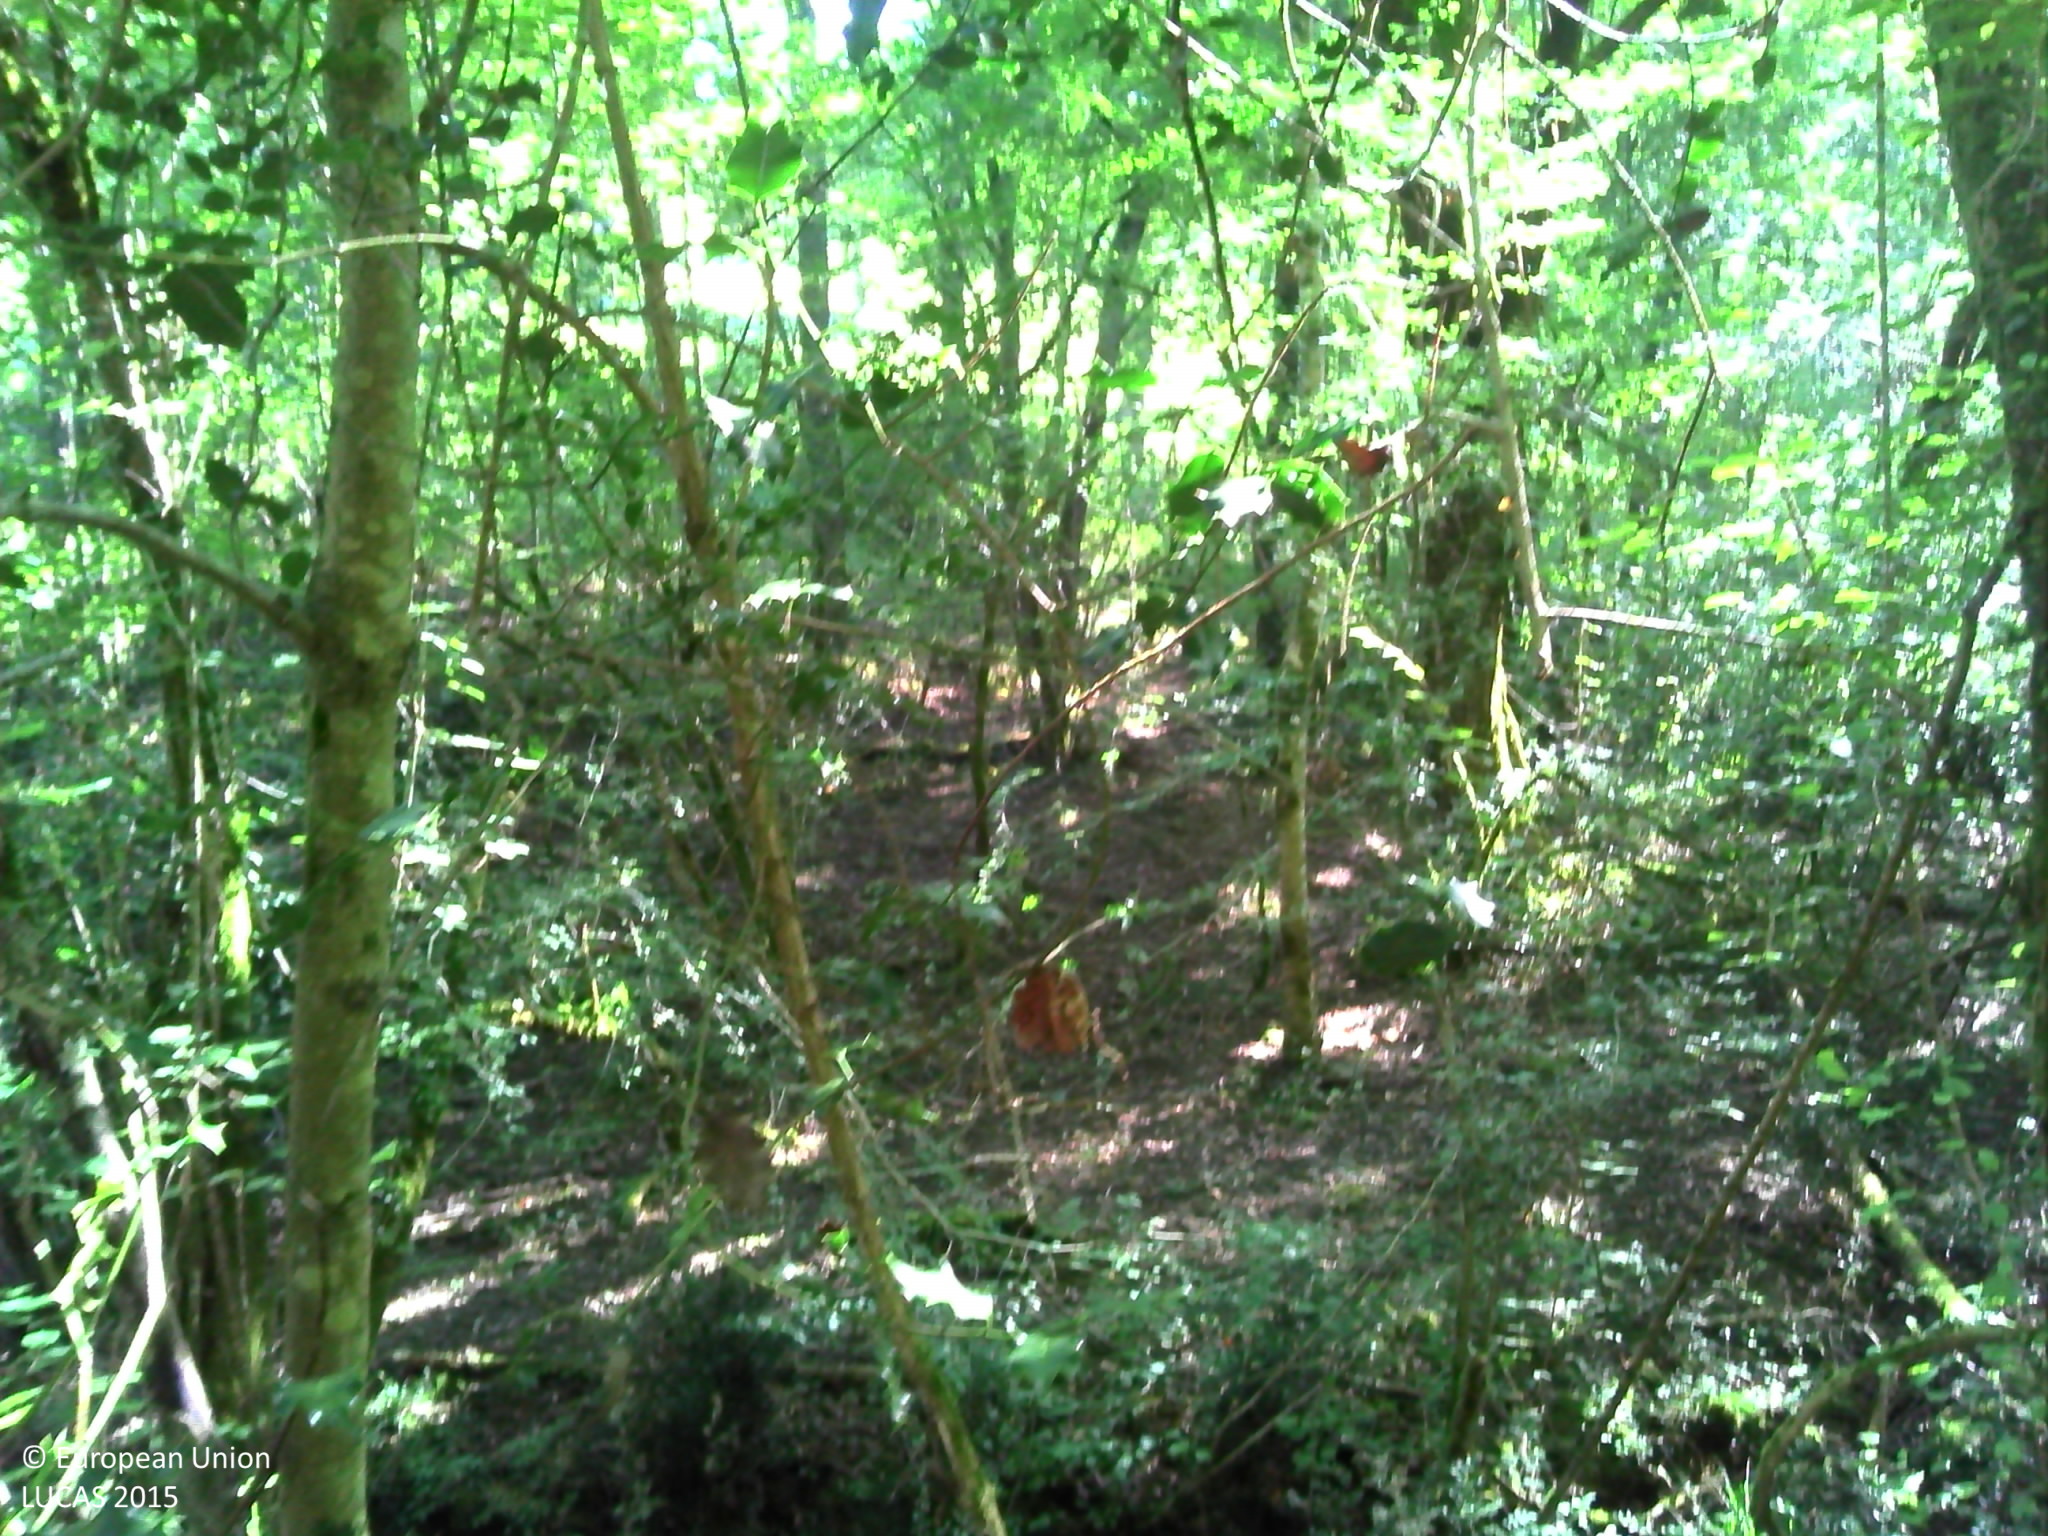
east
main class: Woodland
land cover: Broadleaved woodland
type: mesophytic deciduous forest
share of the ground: 50 - 75 %
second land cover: Spontaneously vegetated surfaces
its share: 25 - 50 %
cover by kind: broadleaved forest trees 70 %, herbaceous plants 15 %, shrubs 10 %, lichens and mosses 5 %
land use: Agriculture (excluding fallow land and kitchen gardens)
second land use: Forestry
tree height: > 5 m
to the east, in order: Broadleaved woodland; Spontaneously vegetated surfaces; Fences; Broadleaved woodland; Rivers and streams; Broadleaved woodland; Grassland with sparse tree/shrub cover; Grassland without tree/shrub cover; Grassland with sparse tree/shrub cover; Abandoned hedges; Electric lines; Grass margins; Paved roads, cycling and walking lanes
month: September
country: FR
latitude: 43.2837
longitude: -1.0669
